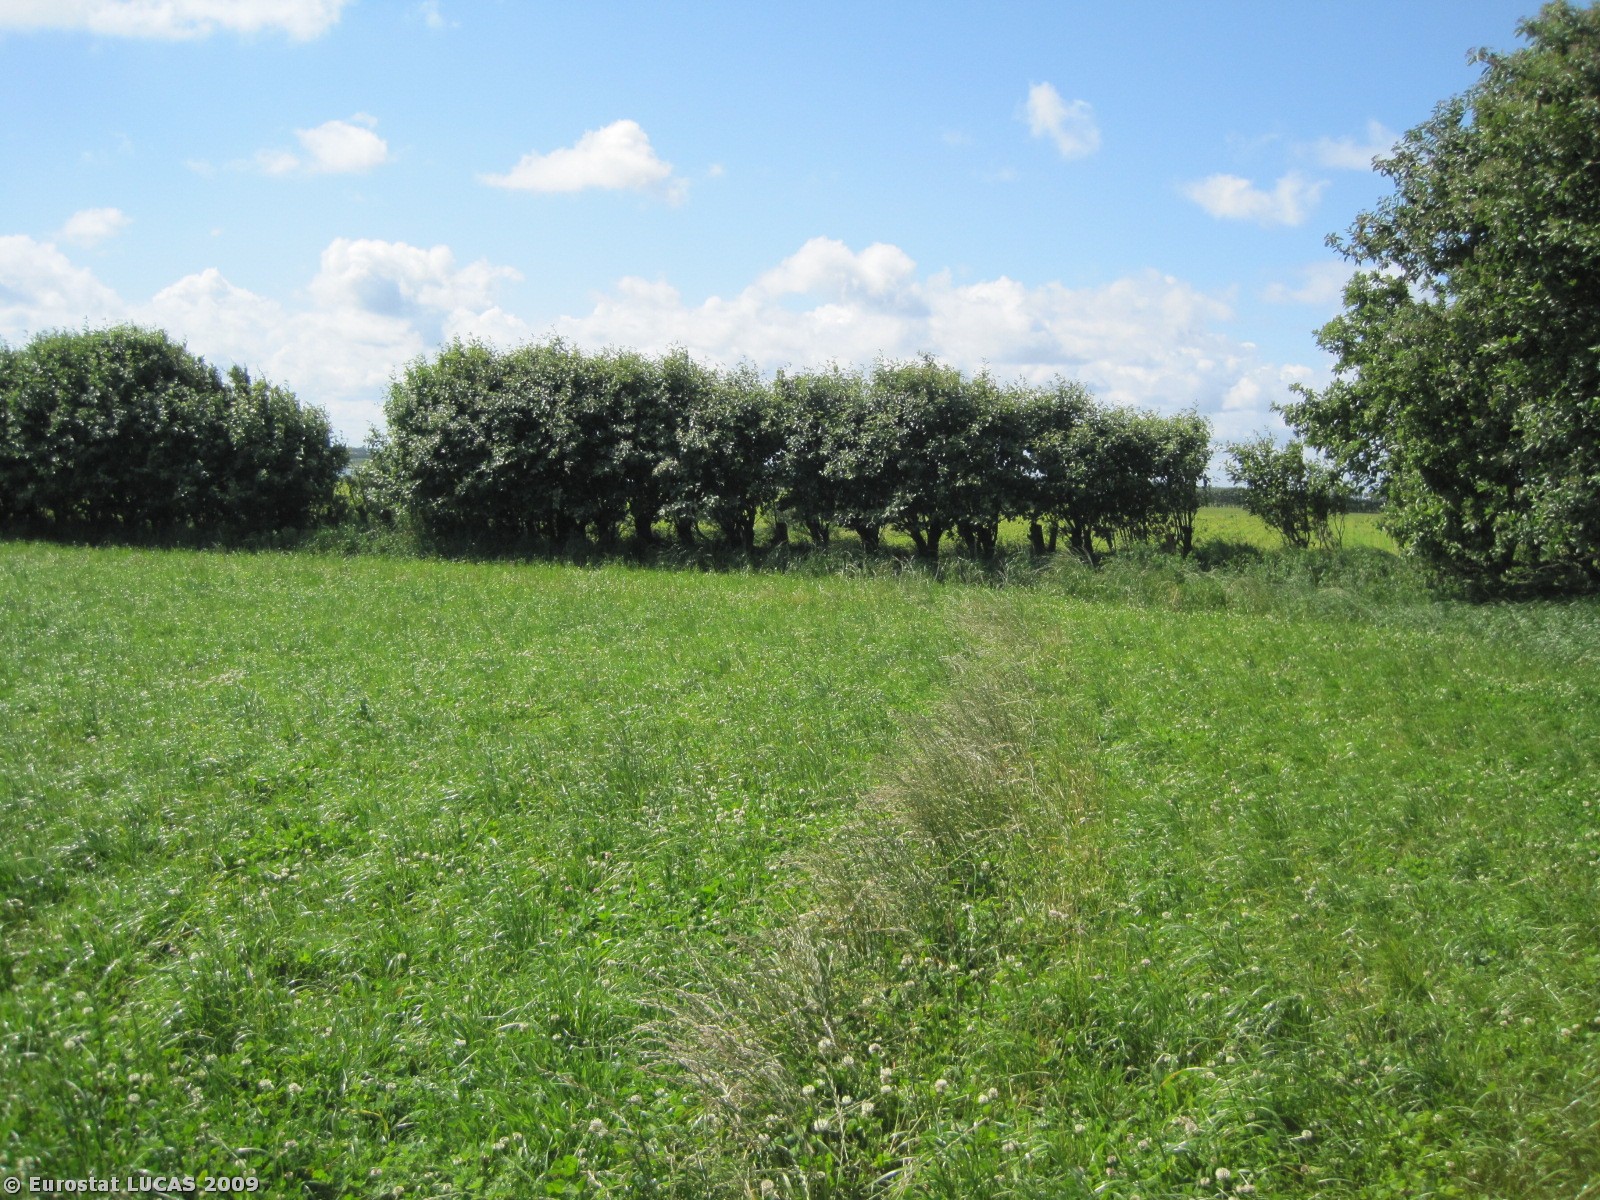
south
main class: Grassland
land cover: Grassland without tree/shrub cover
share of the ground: > 75 %
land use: Agriculture (excluding fallow land and kitchen gardens)
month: June
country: DK
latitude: 56.8866
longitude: 9.2297
